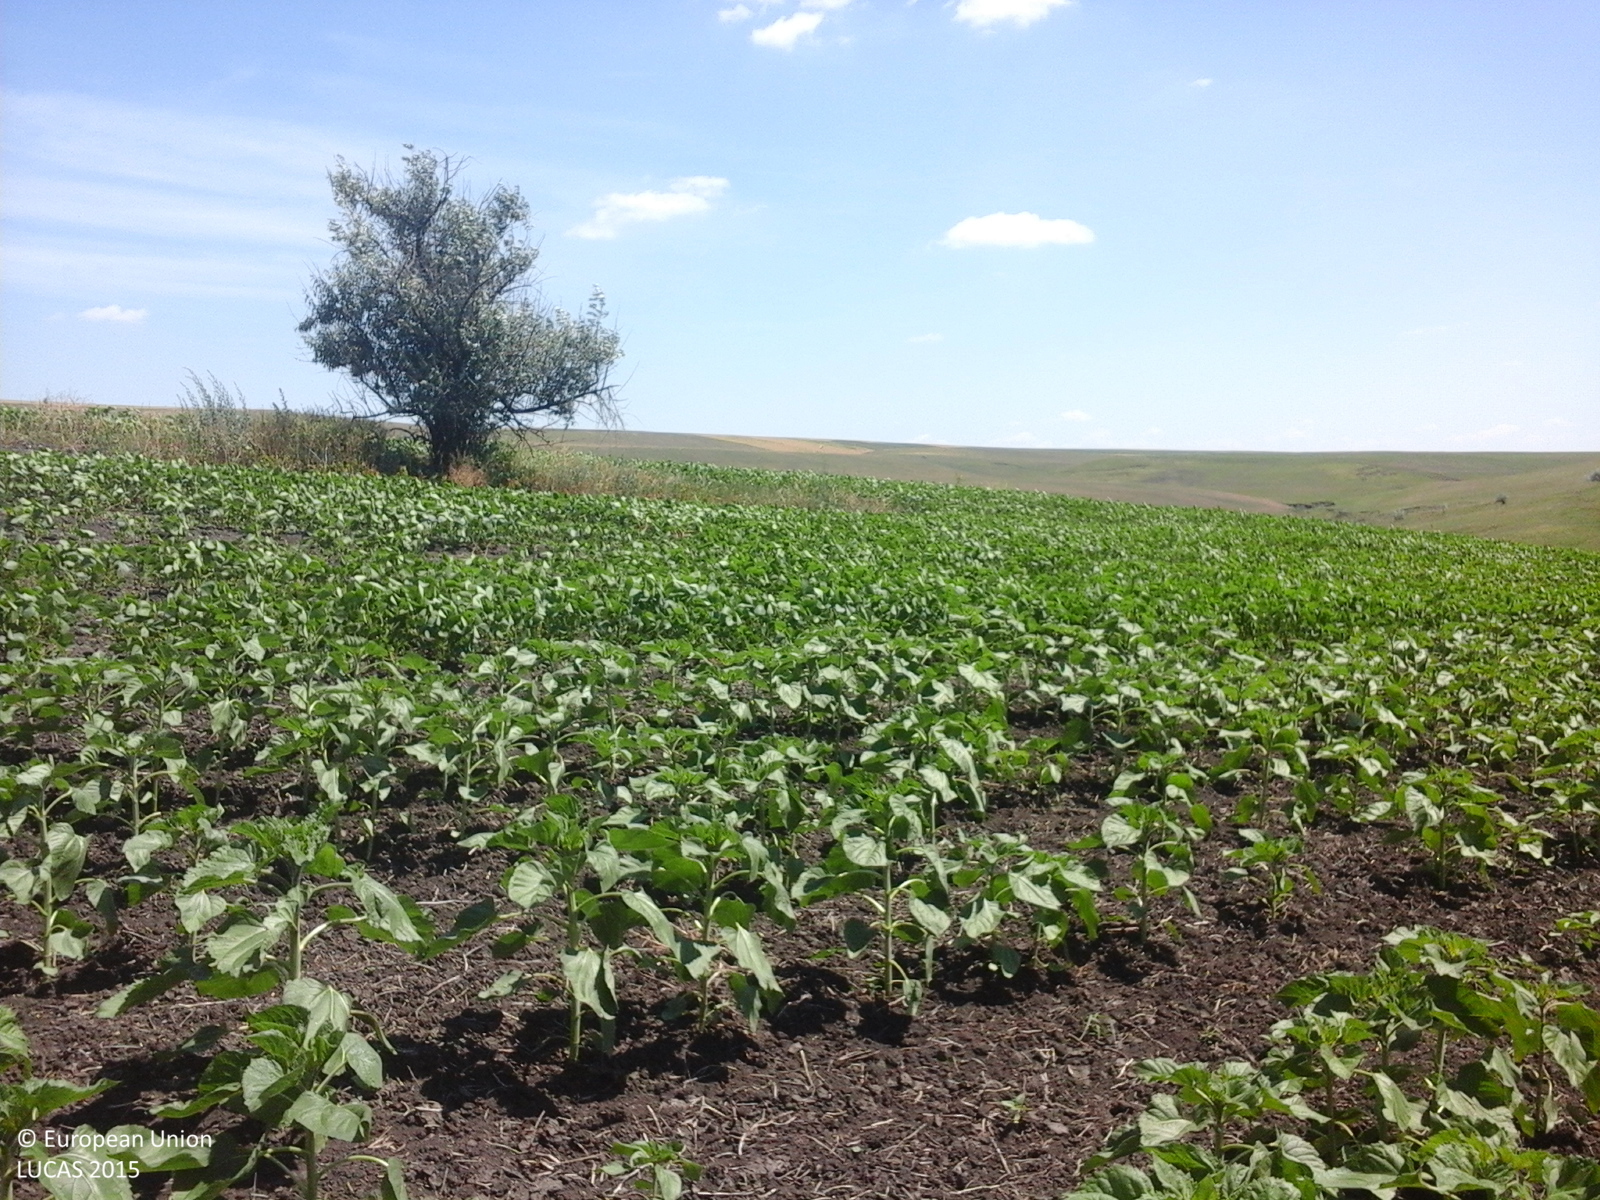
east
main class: Cropland
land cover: Sunflower
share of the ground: 25 - 50 %
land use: Agriculture (excluding fallow land and kitchen gardens)
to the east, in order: Sunflower; Soya; Grassland without tree/shrub cover
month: June
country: RO
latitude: 48.1114
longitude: 26.7135
